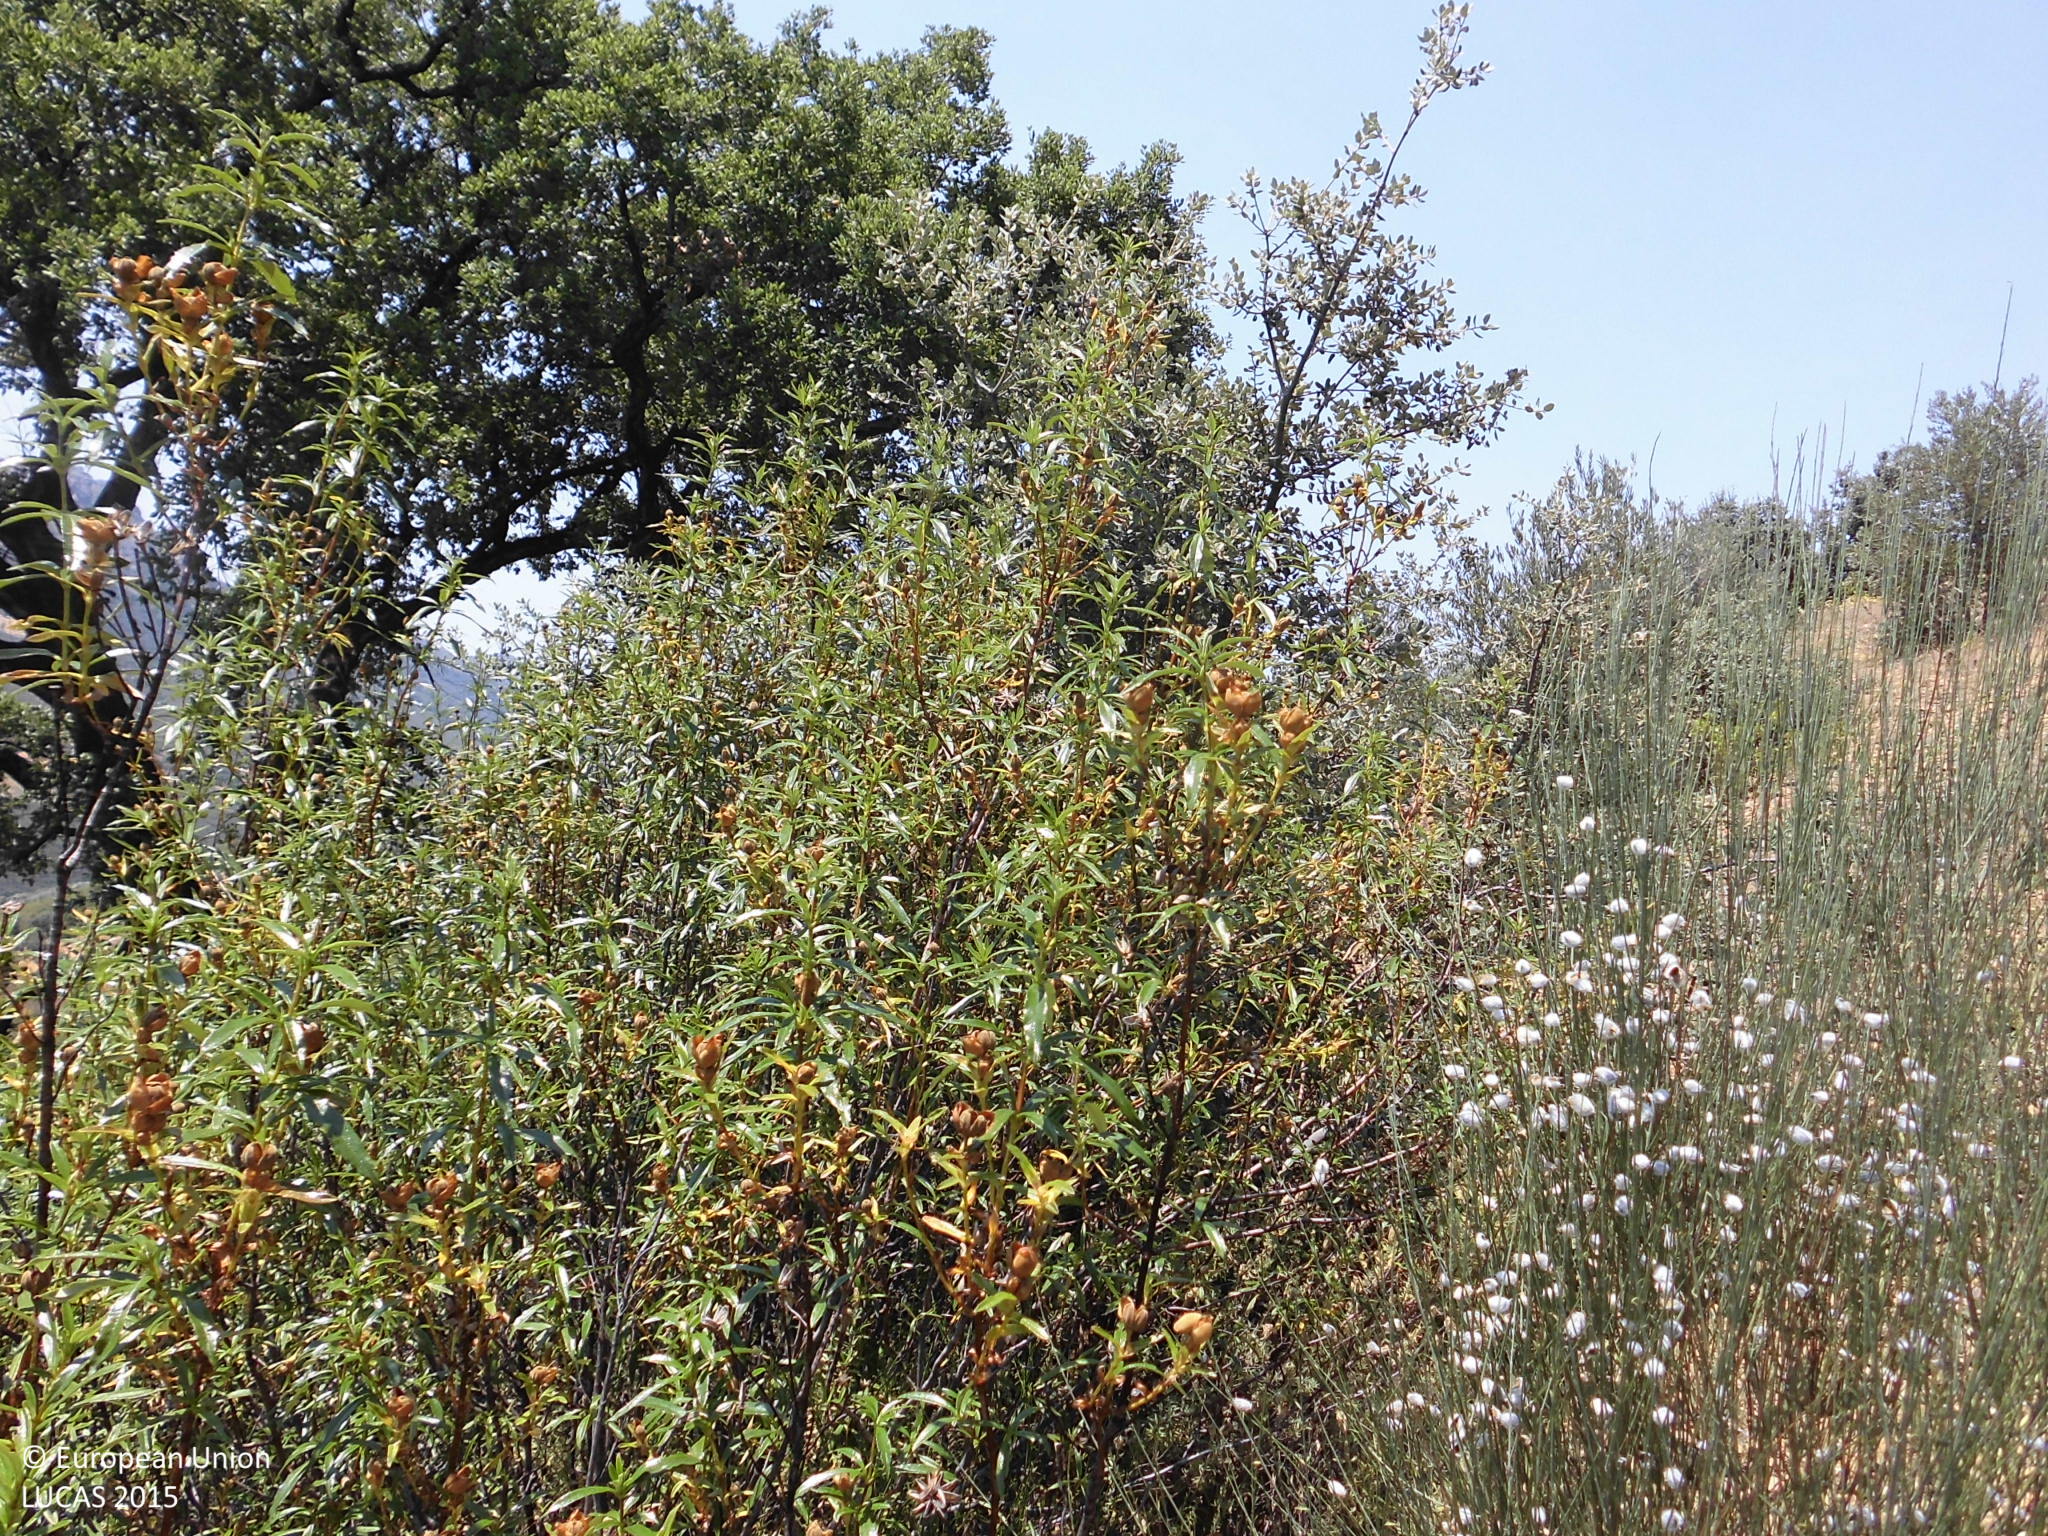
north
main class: Shrubland
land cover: Shrubland without tree cover
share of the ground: > 75 %
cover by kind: shrubs 100 %
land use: Semi-natural and natural areas not in use
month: June
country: ES
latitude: 39.5753
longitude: -5.4066
